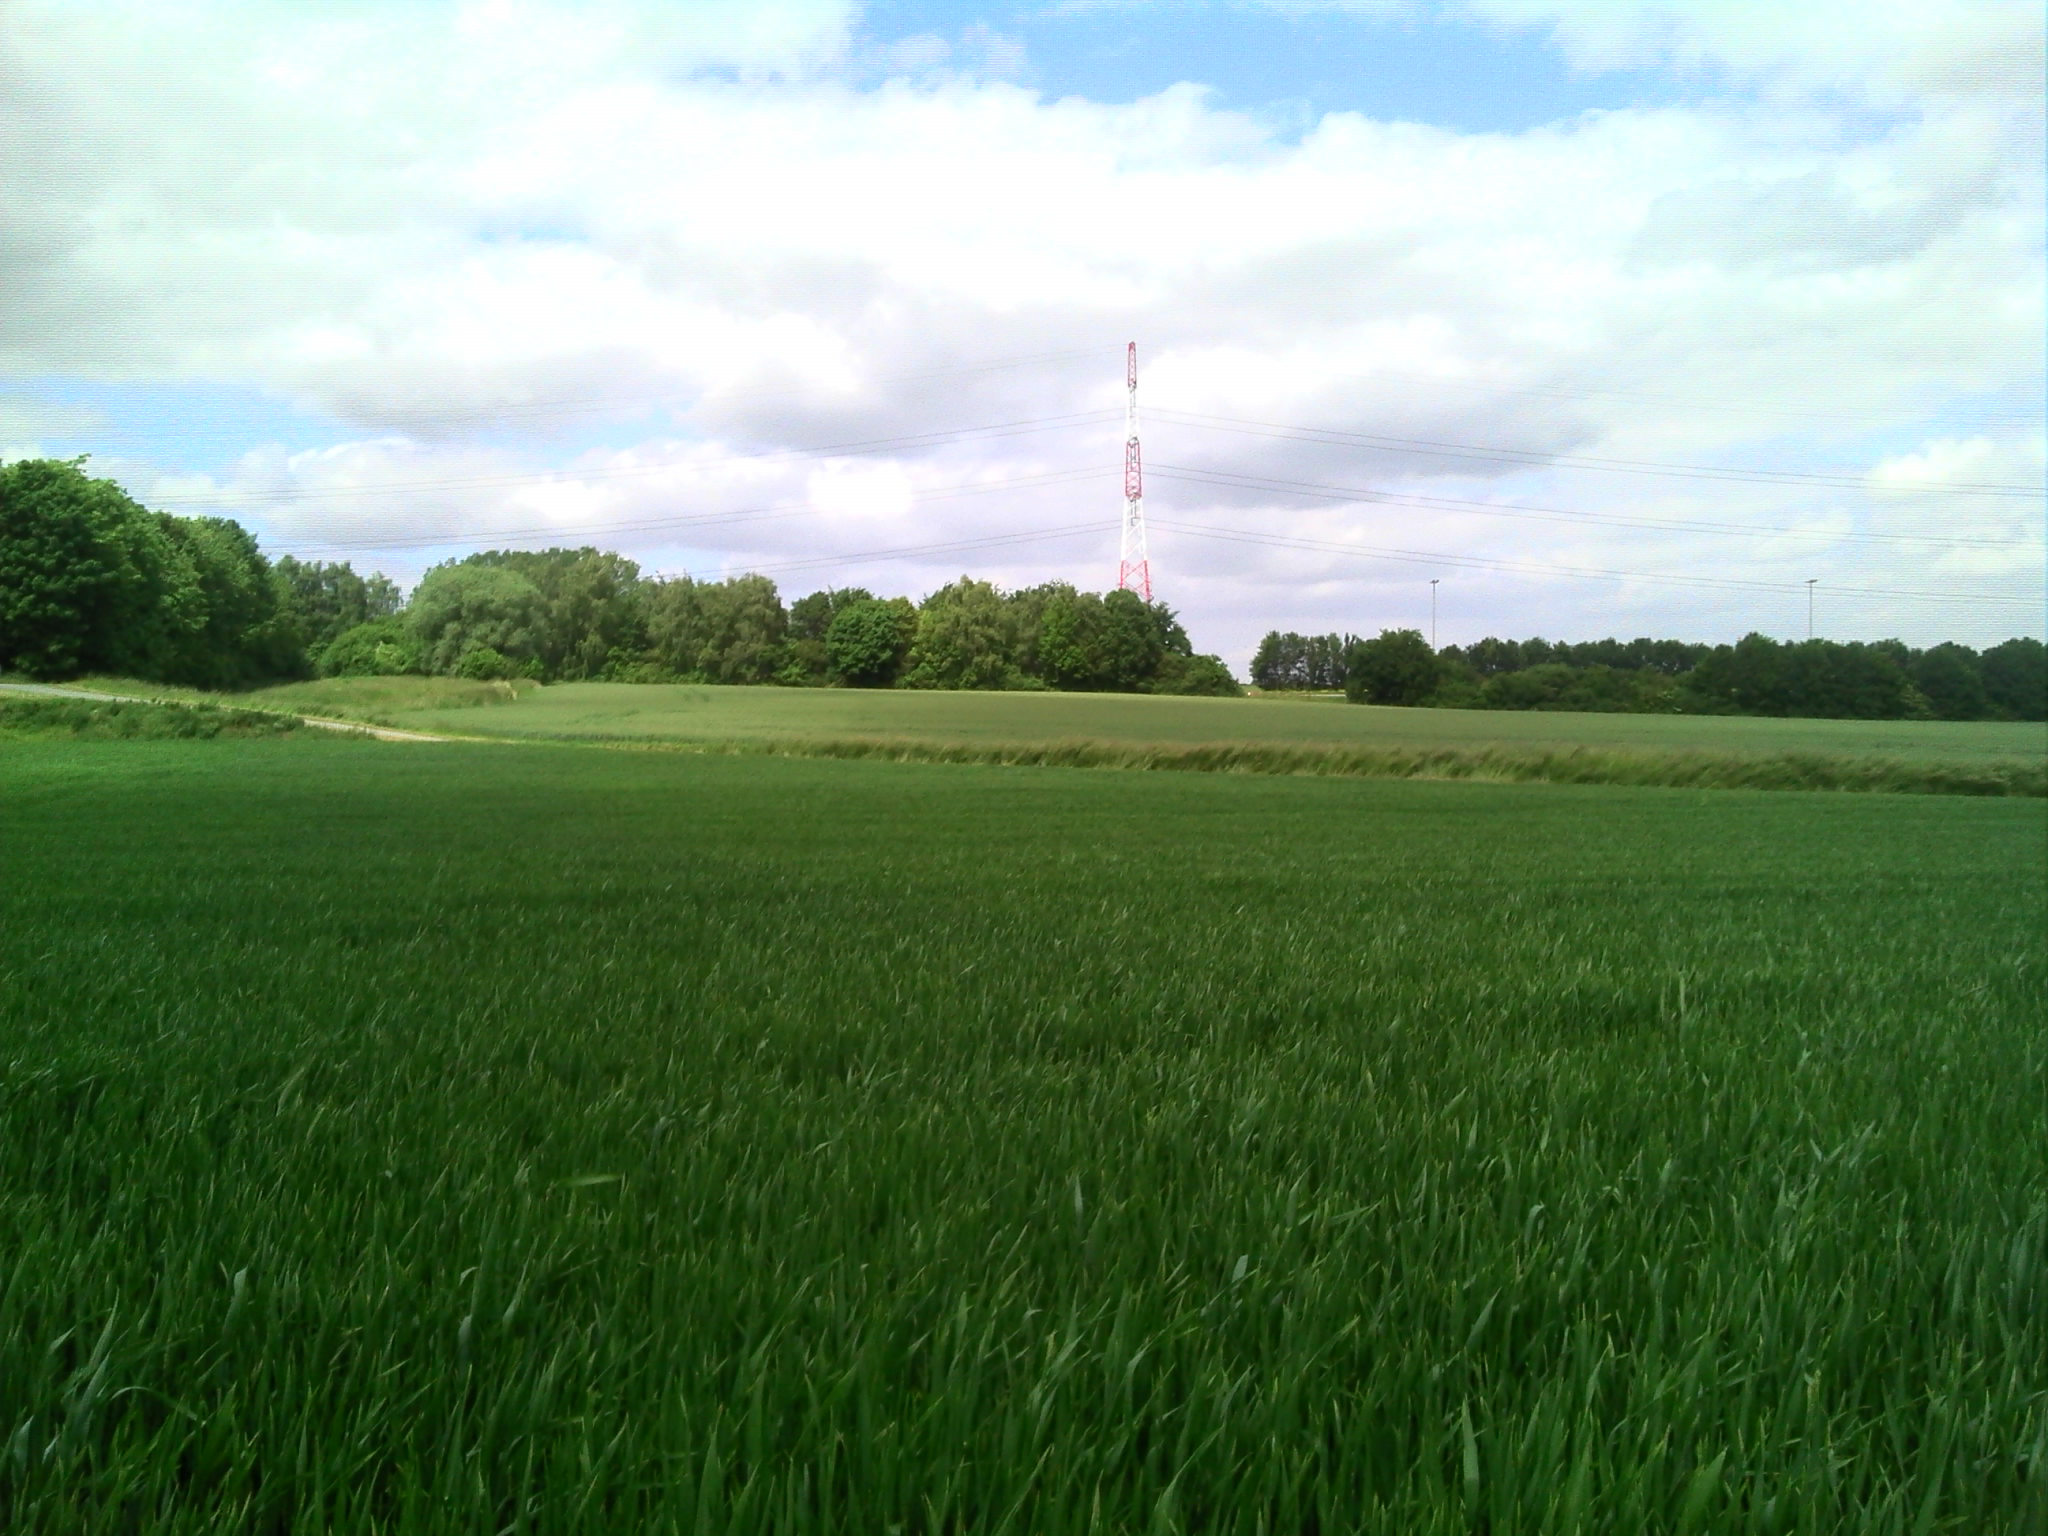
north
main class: Cropland
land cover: Common wheat
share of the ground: > 75 %
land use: Agriculture (excluding fallow land and kitchen gardens)
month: June
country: BE
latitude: 50.4914
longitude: 4.6540
